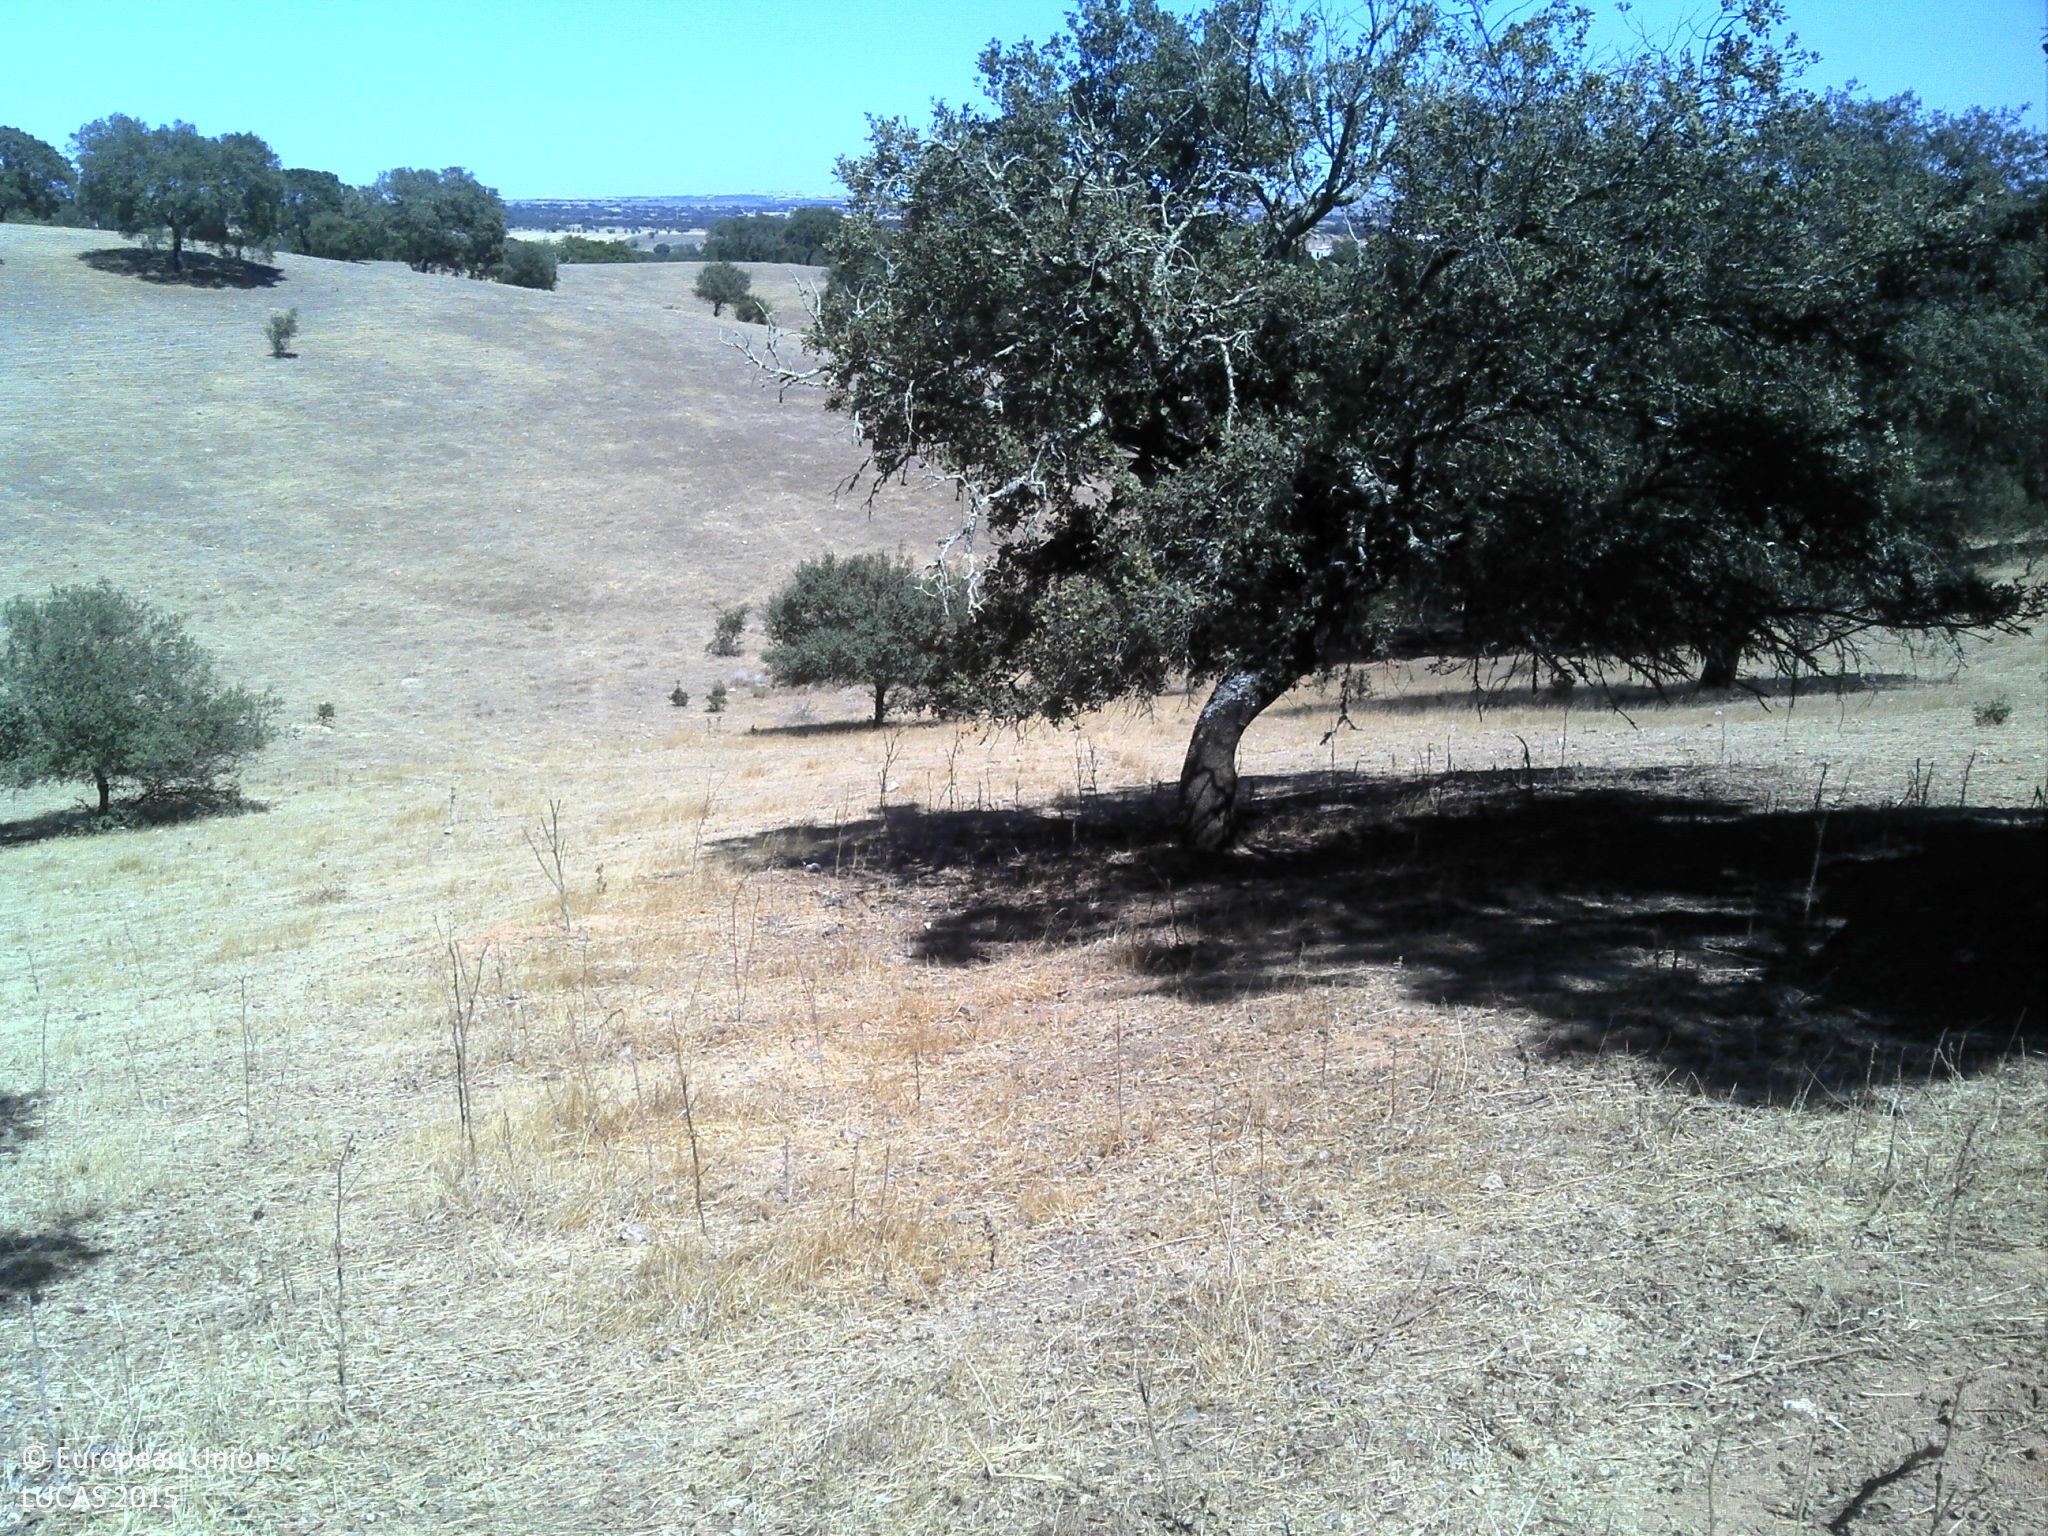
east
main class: Woodland
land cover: Broadleaved woodland
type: broadleaved evergreen forest
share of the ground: > 75 %
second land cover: Grassland without tree/shrub cover
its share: < 10 %
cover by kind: broadleaved forest trees 95 %, herbaceous plants 5 %
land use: Agriculture (excluding fallow land and kitchen gardens)
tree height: > 5 m
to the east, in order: Broadleaved woodland; Grassland without tree/shrub cover; Broadleaved woodland; Grassland without tree/shrub cover; Broadleaved woodland; Grassland without tree/shrub cover; Broadleaved woodland; Grassland with sparse tree/shrub cover
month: July
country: PT
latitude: 38.0022
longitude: -8.0598
